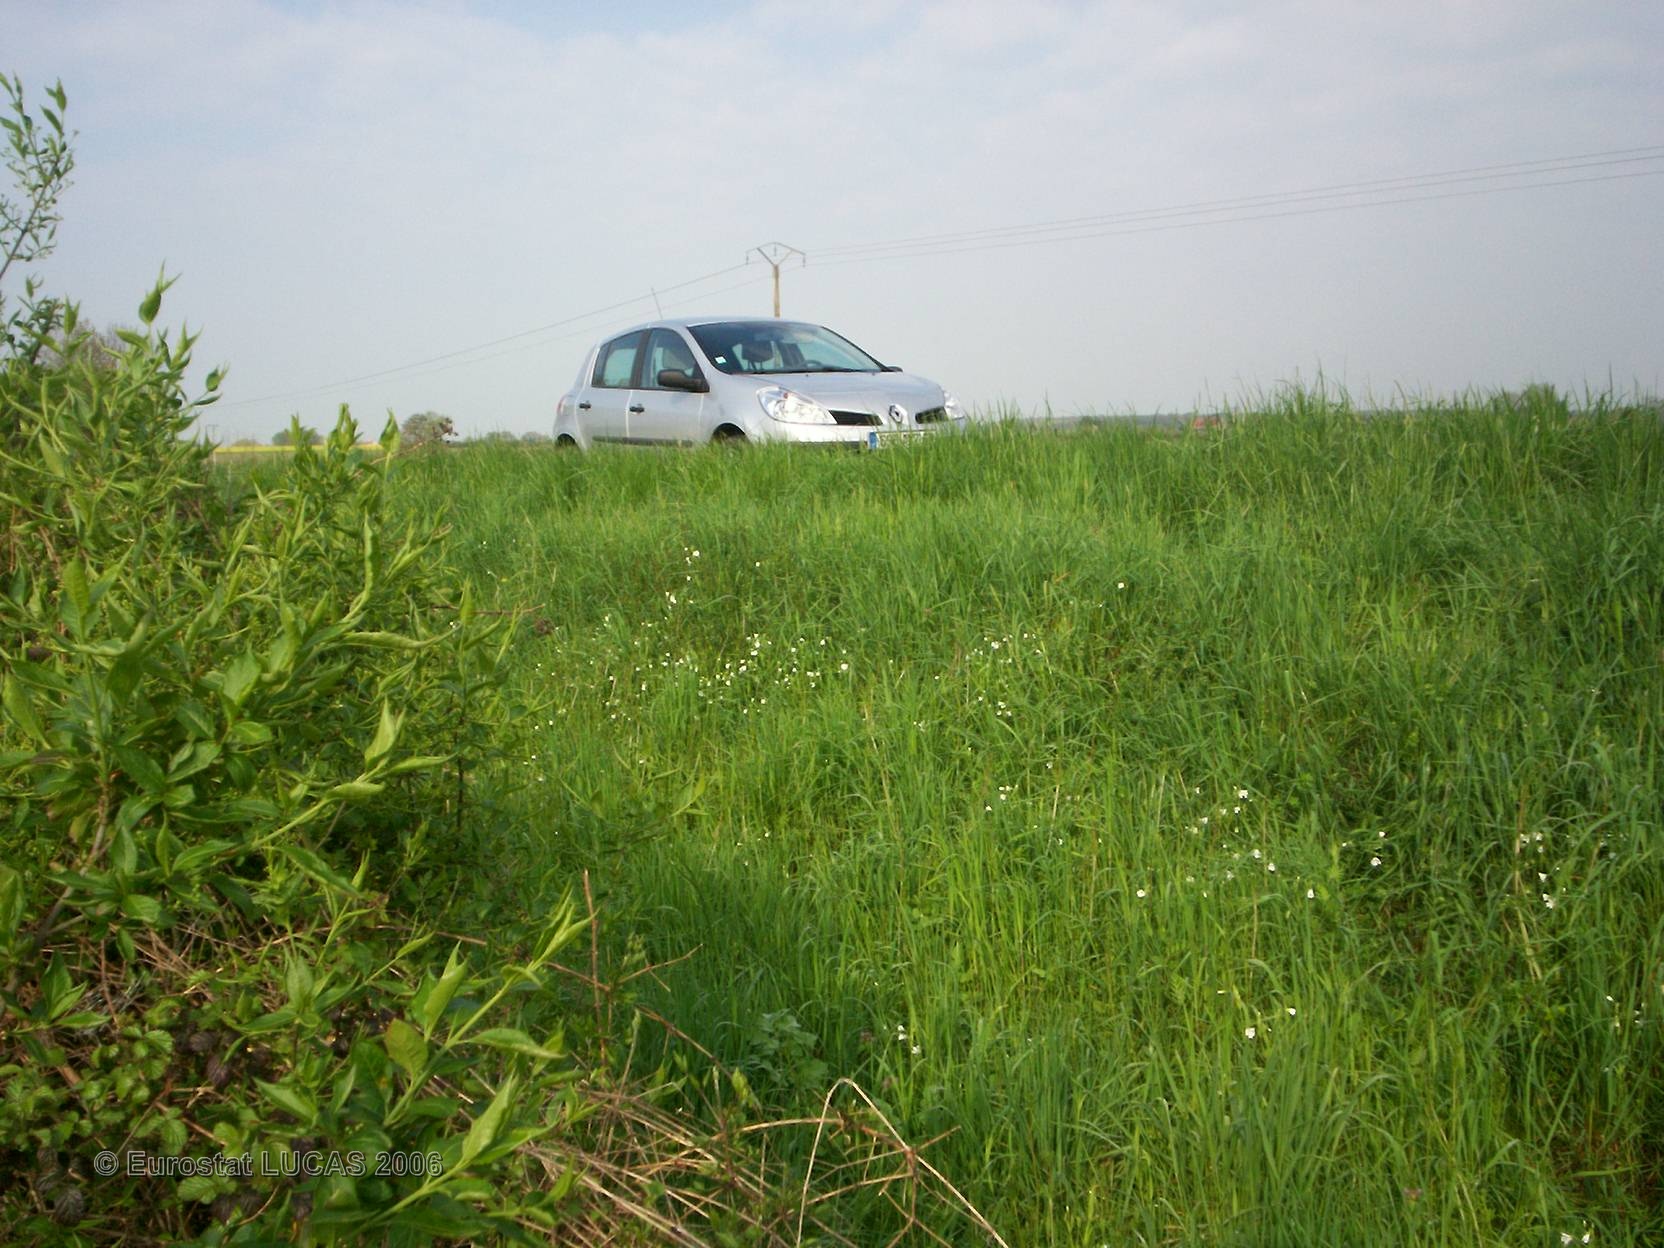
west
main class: Grassland
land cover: Grassland without tree/shrub cover
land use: Agriculture (excluding fallow land and kitchen gardens)
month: April
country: FR
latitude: 47.2119
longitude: 3.0901
